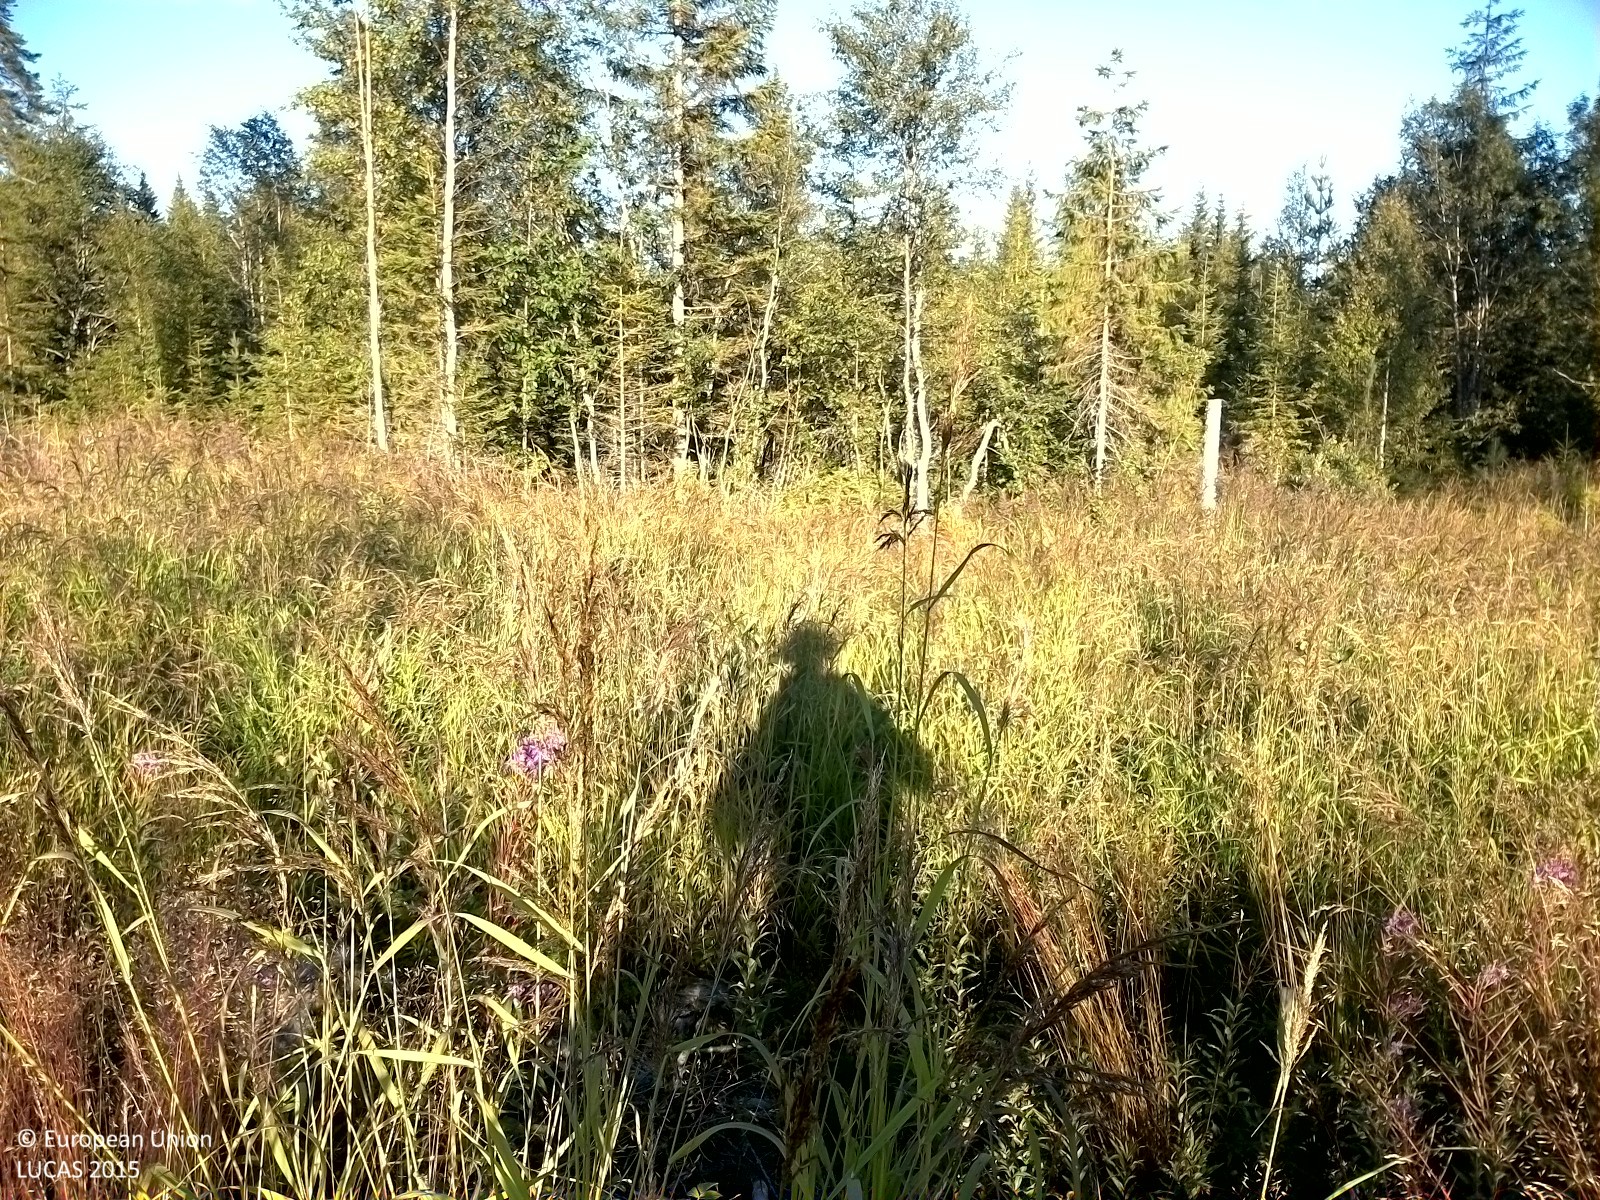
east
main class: Grassland
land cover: Grassland with sparse tree/shrub cover
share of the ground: > 75 %
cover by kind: herbaceous plants 90 %, broadleaved forest trees 5 %, unconsolidated bare surface 5 %
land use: Forestry
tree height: < 5 m
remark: Clear cut
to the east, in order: Grassland with sparse tree/shrub cover; Broadleaved woodland; Other coniferous woodland; Spruce dominated coniferous woodland; Other mixed woodland; Other coniferous woodland
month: August
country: SE
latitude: 62.3654
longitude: 16.4539
